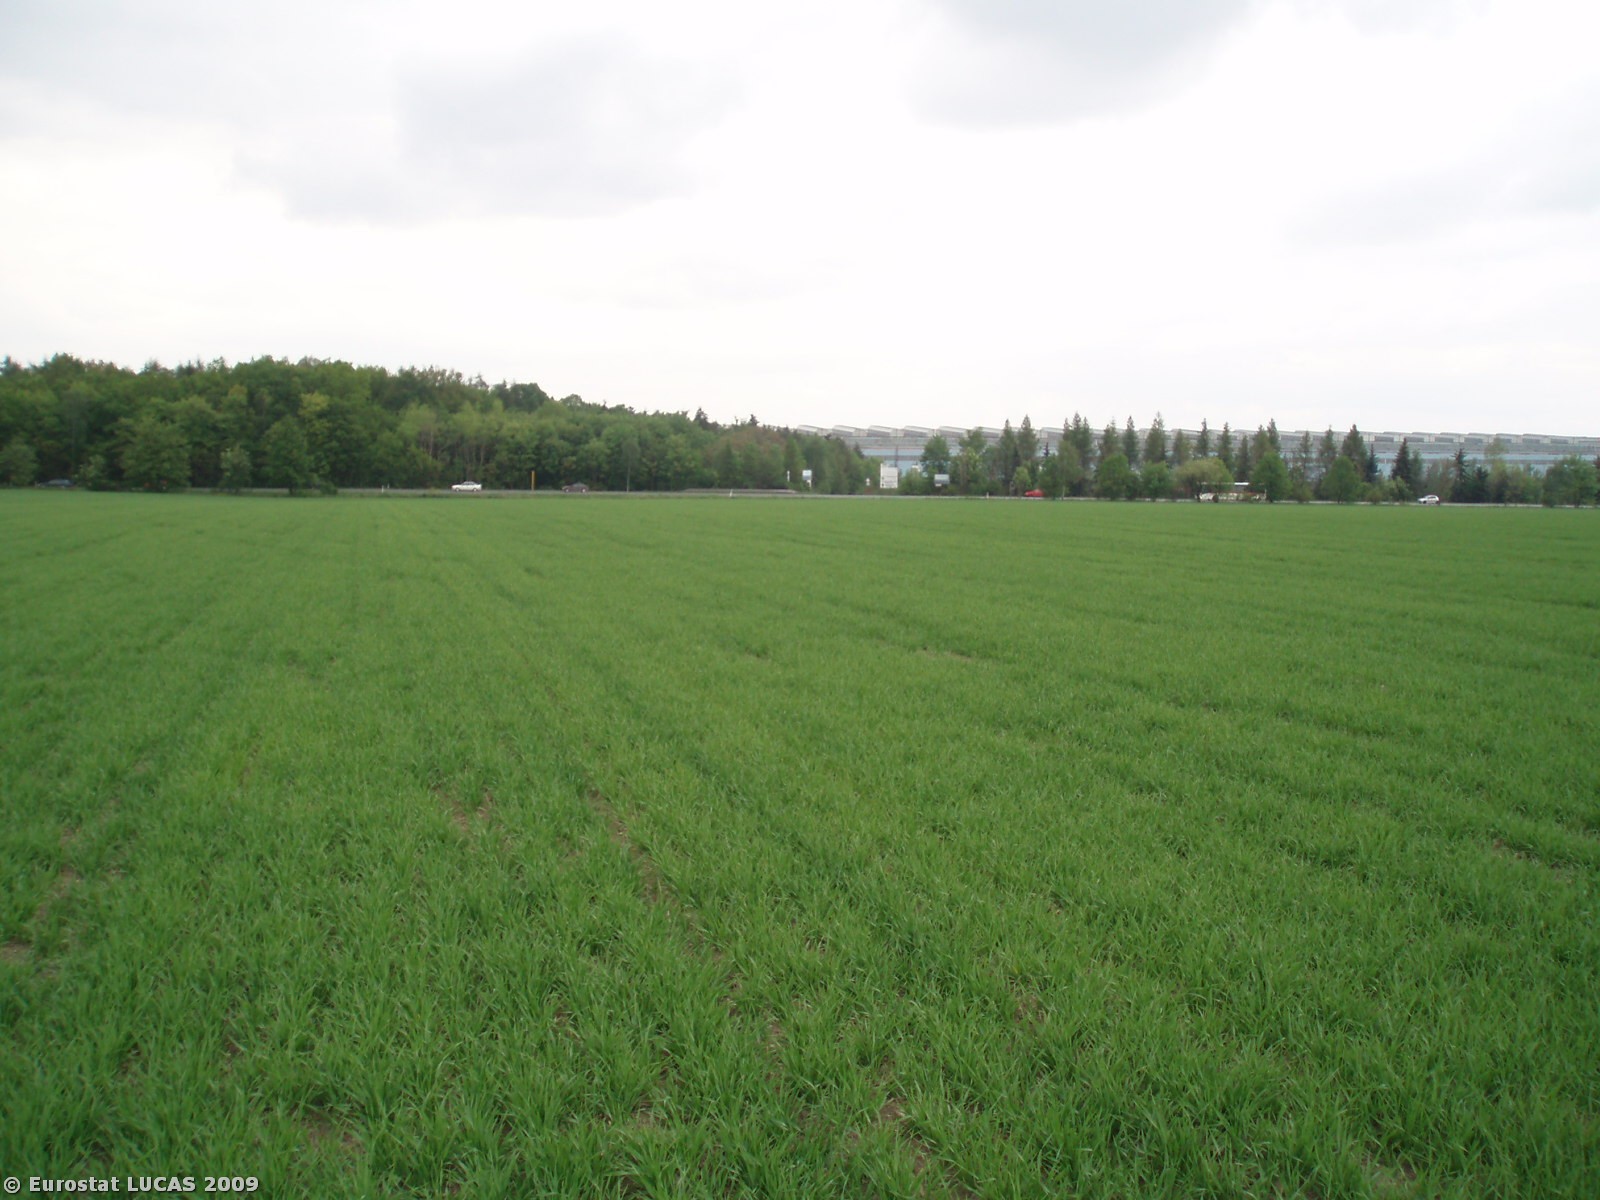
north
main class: Cropland
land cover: Barley
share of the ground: > 75 %
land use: Agriculture (excluding fallow land and kitchen gardens)
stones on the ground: < 10 %
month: May
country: CZ
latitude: 50.1445
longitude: 14.1571
